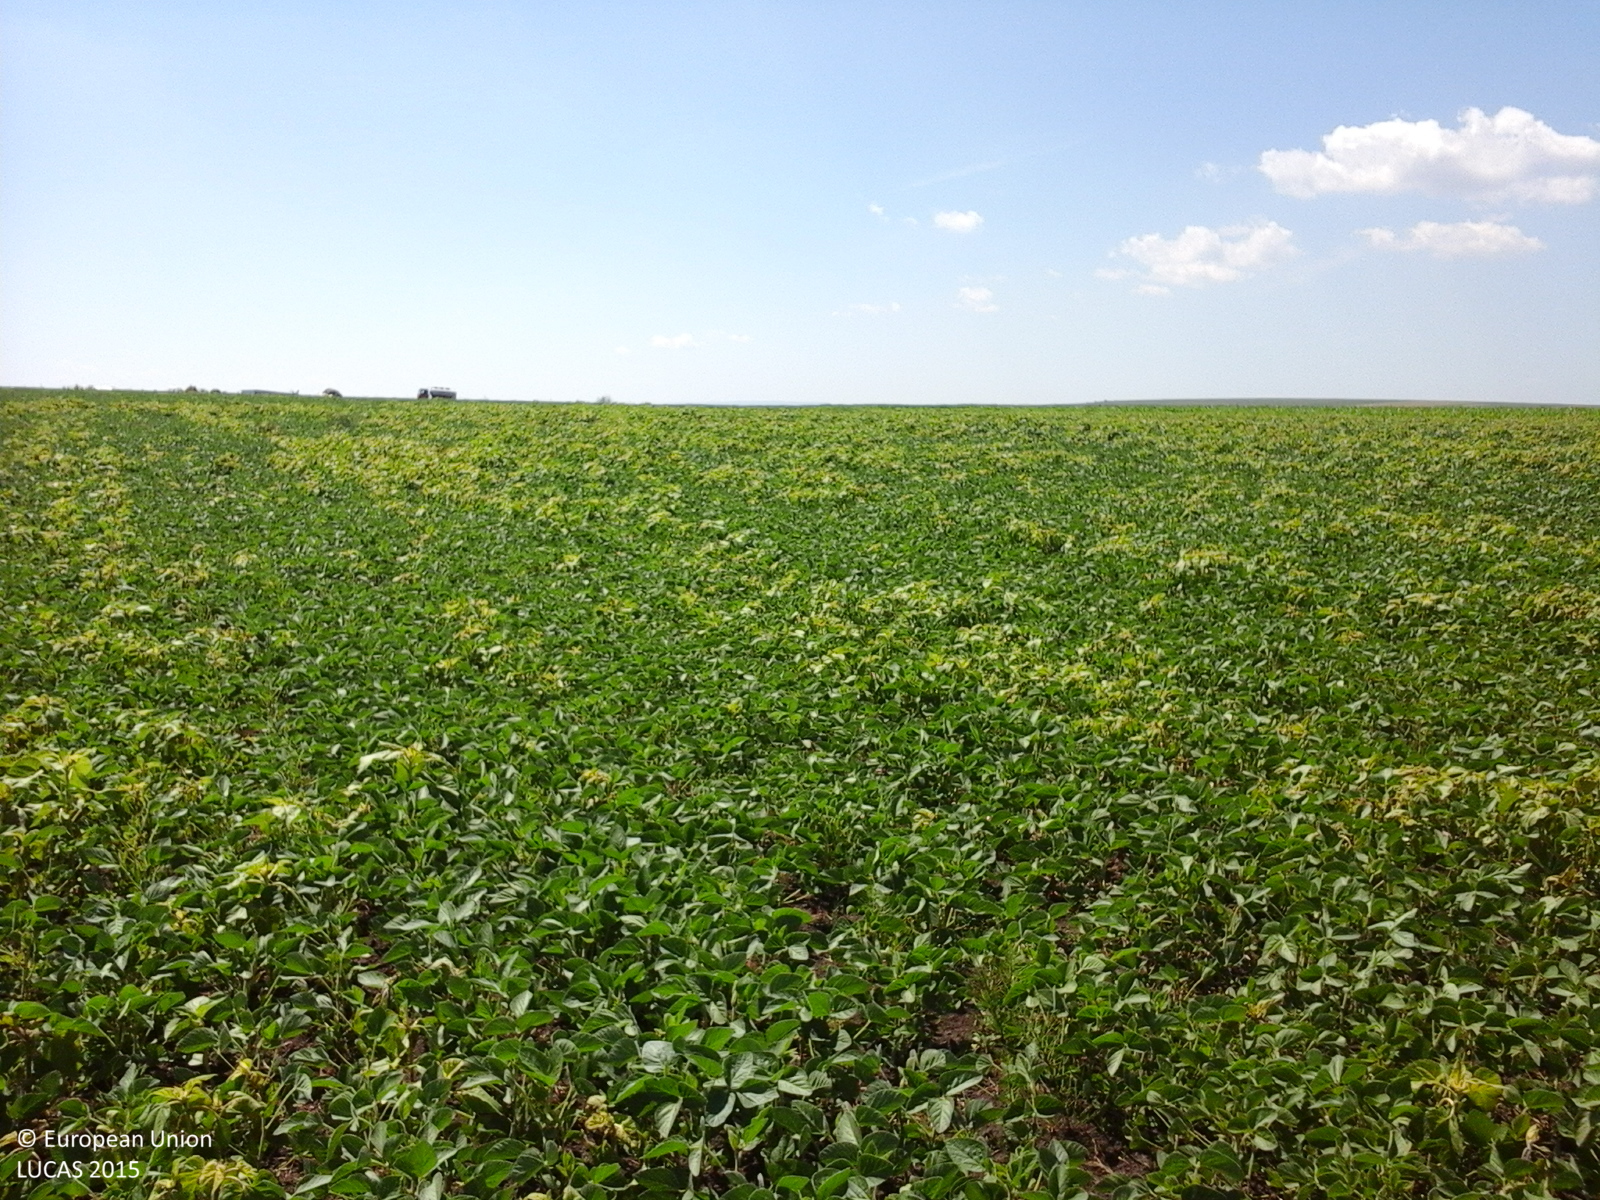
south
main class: Cropland
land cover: Soya
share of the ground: > 75 %
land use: Agriculture (excluding fallow land and kitchen gardens)
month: June
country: RO
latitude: 47.8344
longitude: 26.8408
